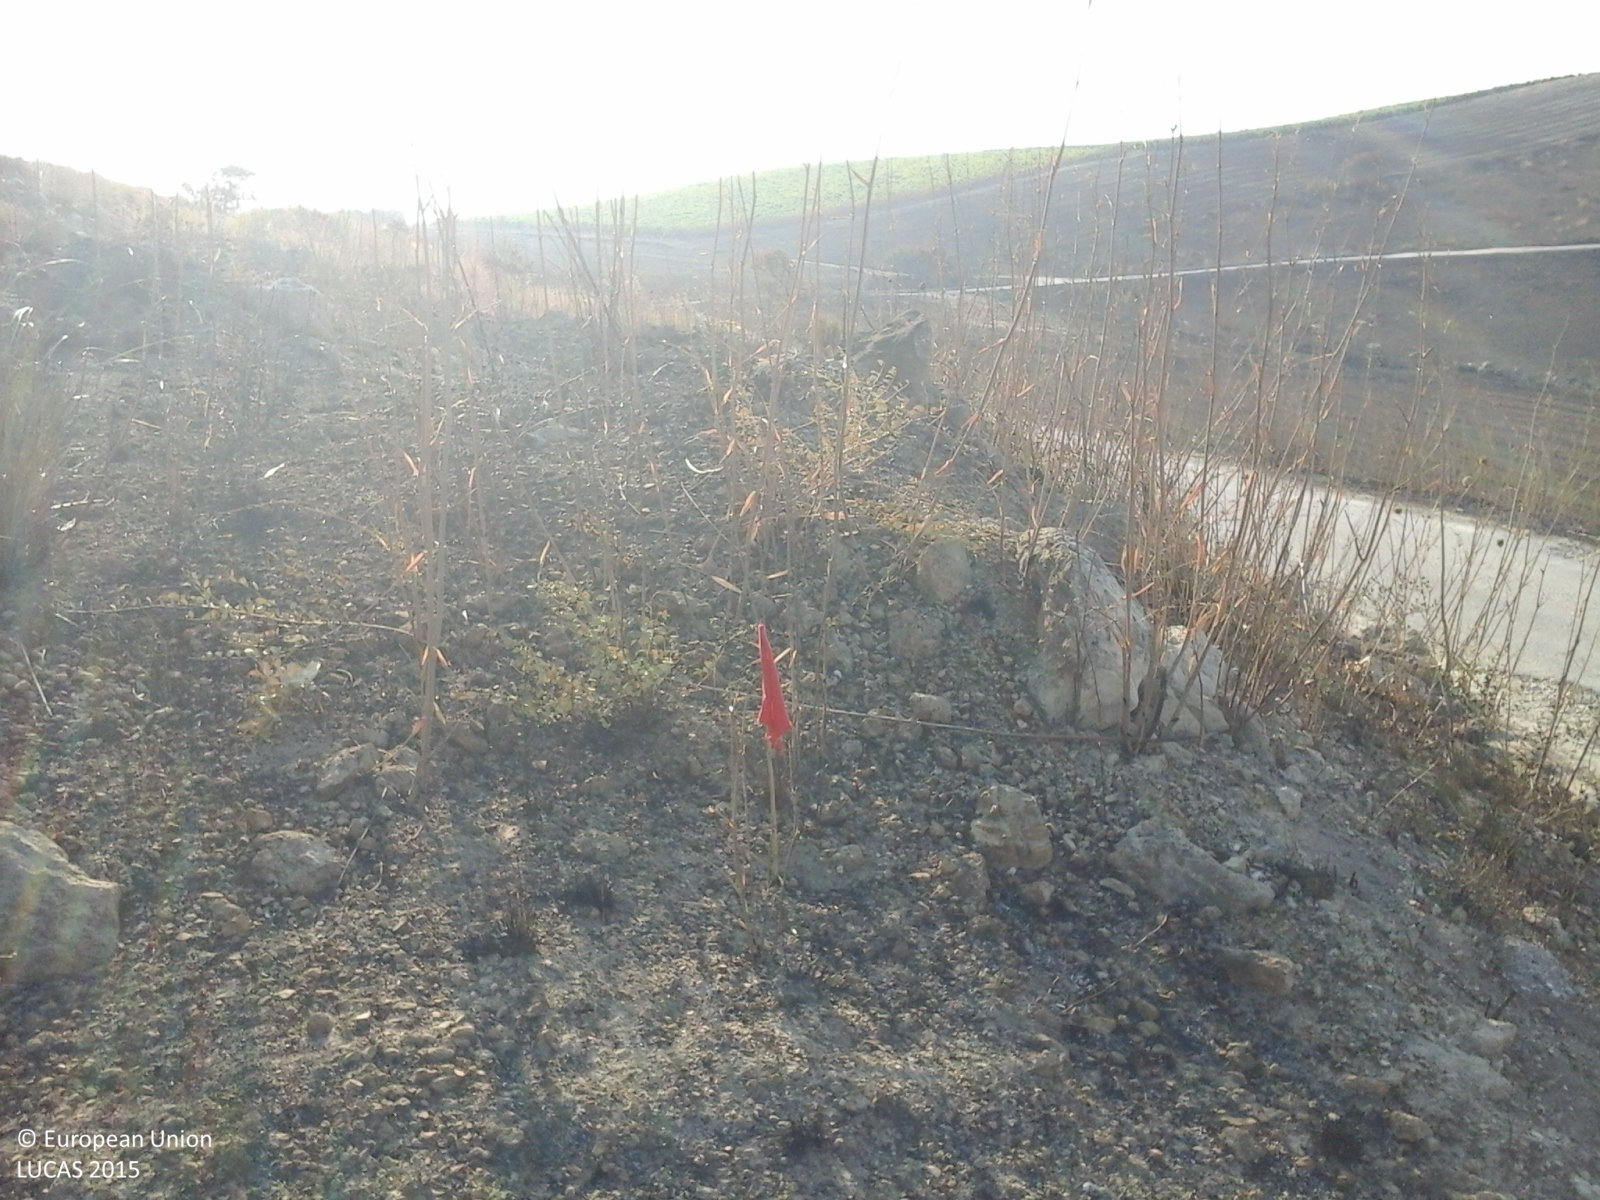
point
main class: Grassland
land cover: Grassland without tree/shrub cover
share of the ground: > 75 %
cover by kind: herbaceous plants 100 %
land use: Semi-natural and natural areas not in use
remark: Burnt area
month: July
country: IT
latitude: 37.2437
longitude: 14.0382
